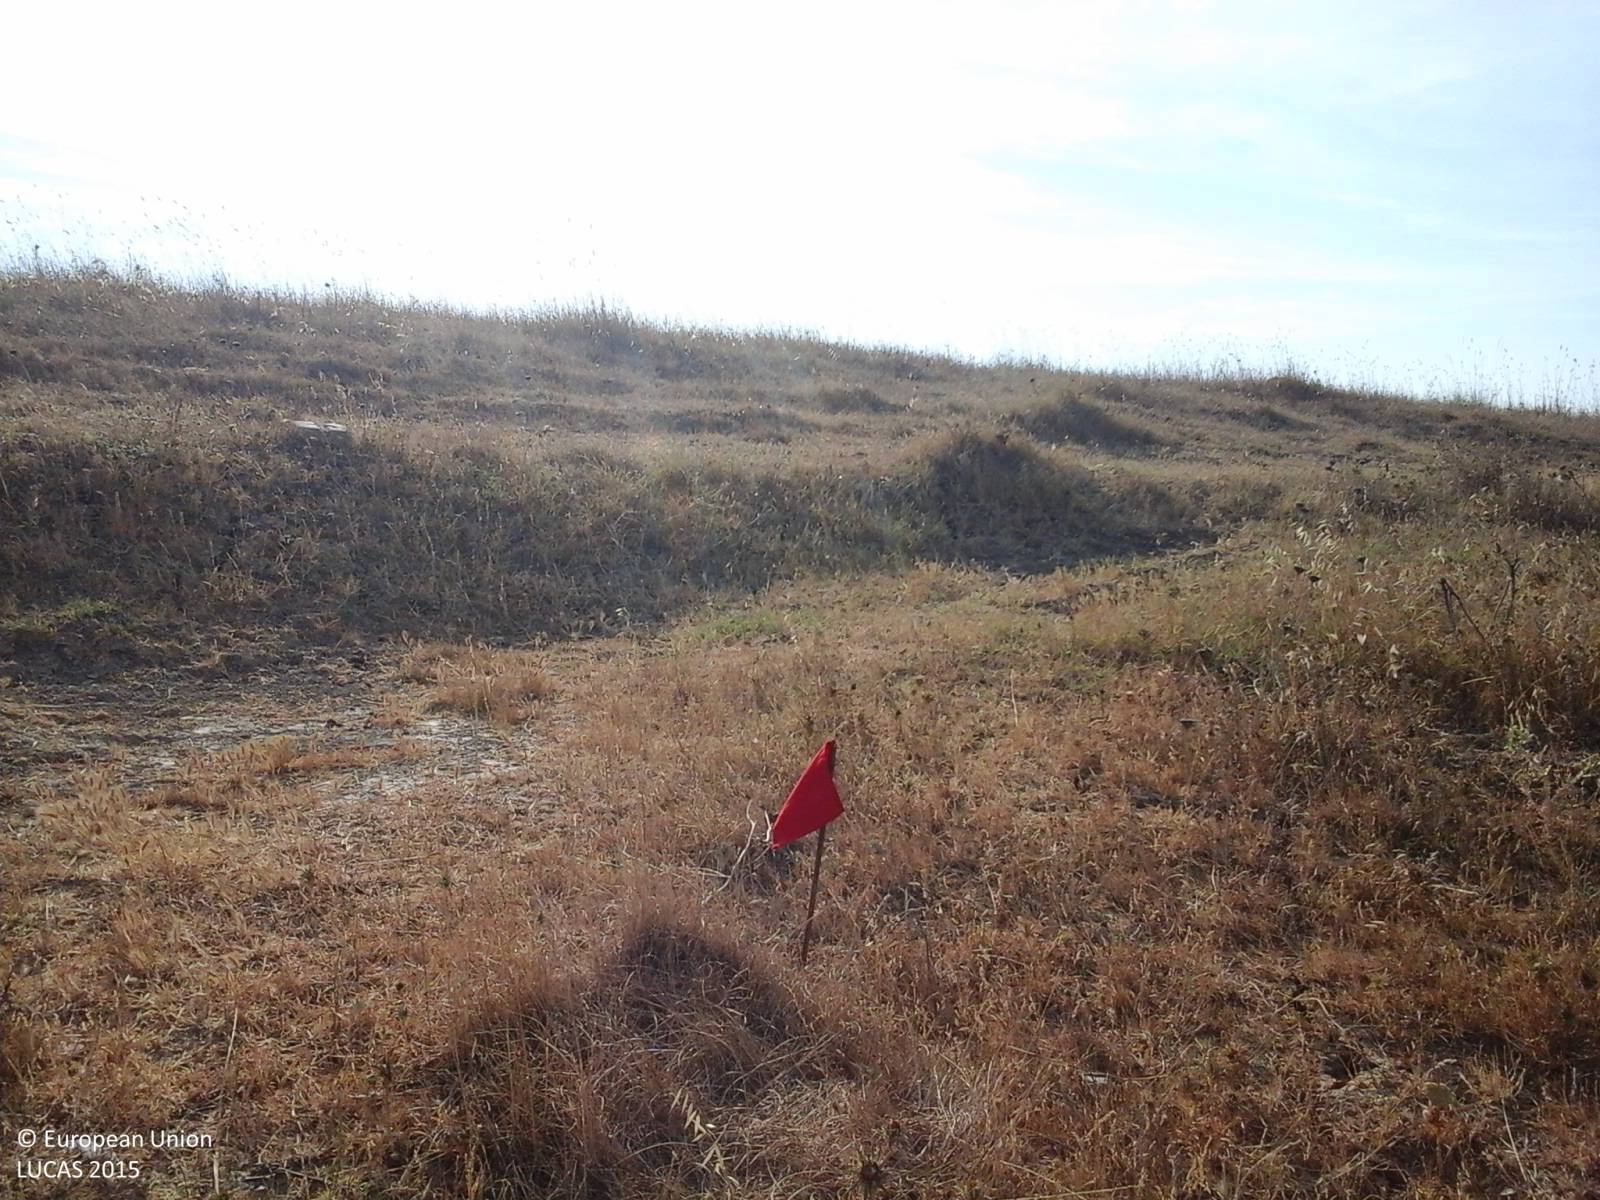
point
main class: Grassland
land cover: Grassland without tree/shrub cover
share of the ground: > 75 %
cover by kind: herbaceous plants 100 %
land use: Agriculture (excluding fallow land and kitchen gardens)
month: June
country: IT
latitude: 37.8033
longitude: 12.5816
